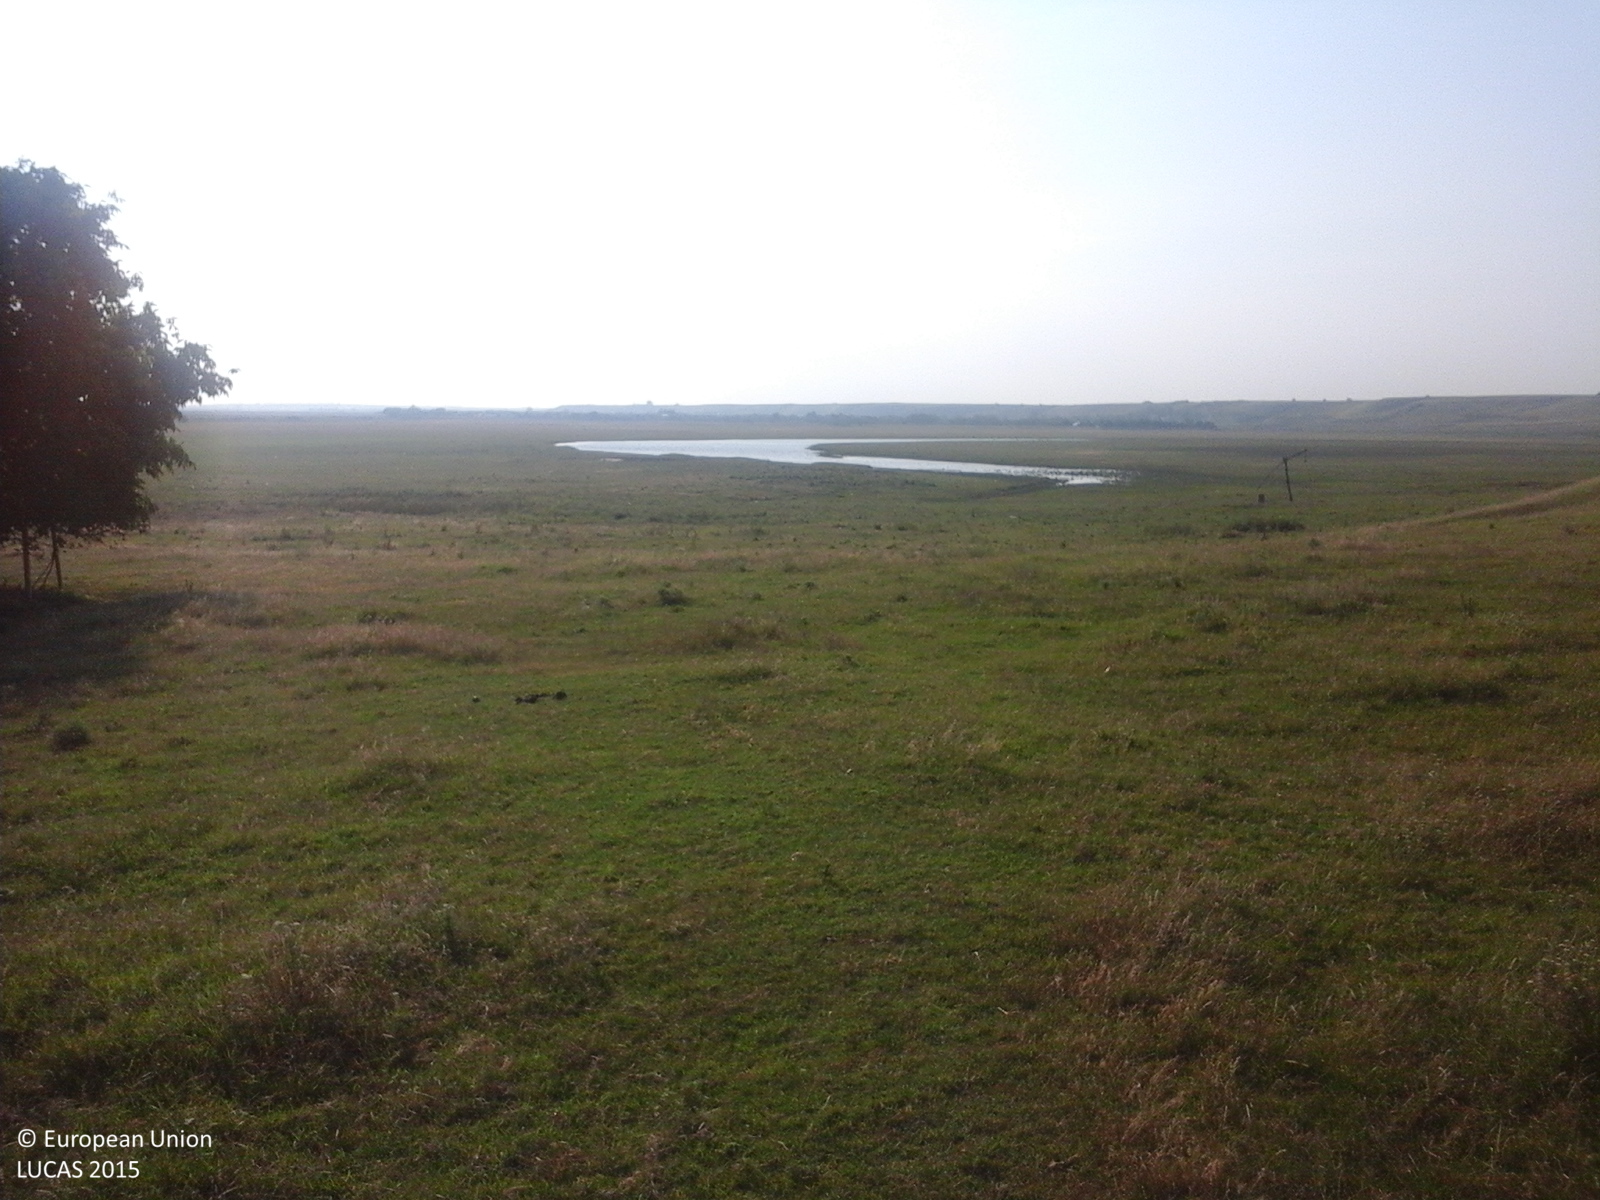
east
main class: Grassland
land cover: Grassland without tree/shrub cover
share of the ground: > 75 %
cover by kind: herbaceous plants 100 %
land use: Agriculture (excluding fallow land and kitchen gardens)
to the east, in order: Grassland without tree/shrub cover; Other bare soil; Grassland without tree/shrub cover; Spontaneously vegetated surfaces; Grassland without tree/shrub cover
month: July
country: RO
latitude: 44.5445
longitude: 27.0599
